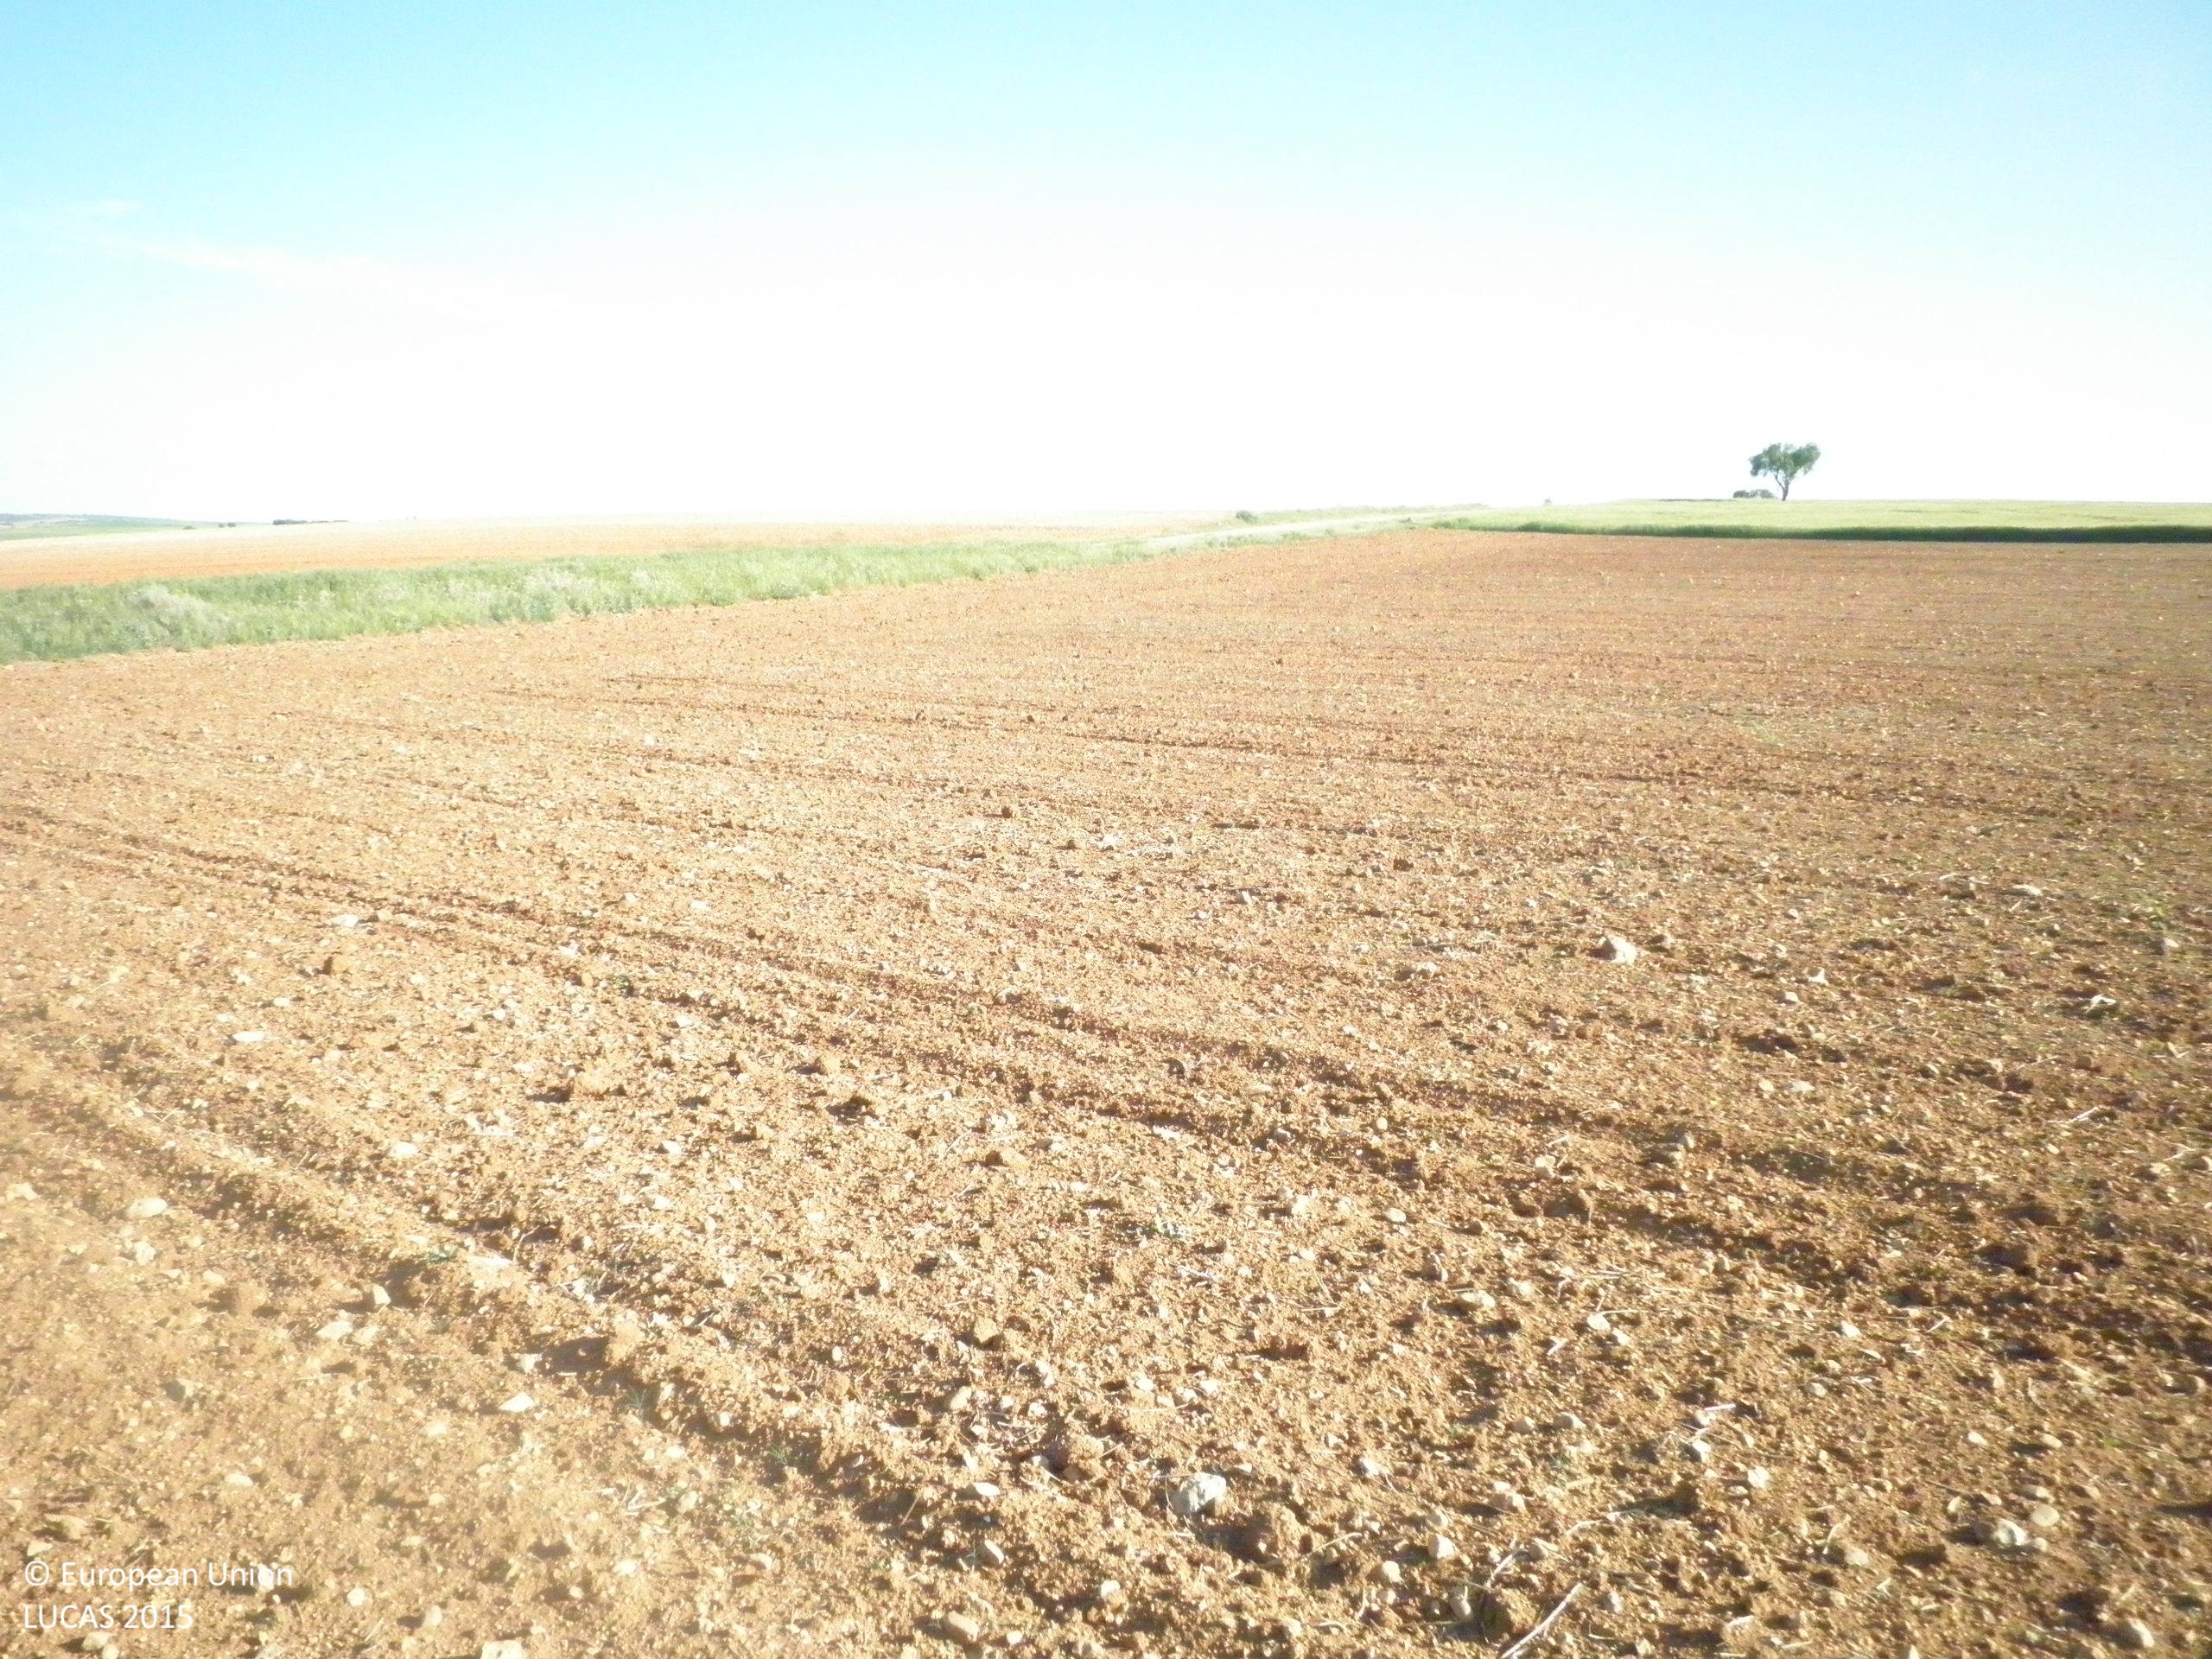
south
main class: Cropland
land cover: Rye
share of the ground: > 75 %
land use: Agriculture (excluding fallow land and kitchen gardens)
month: May
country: ES
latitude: 39.6864
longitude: -2.7616
